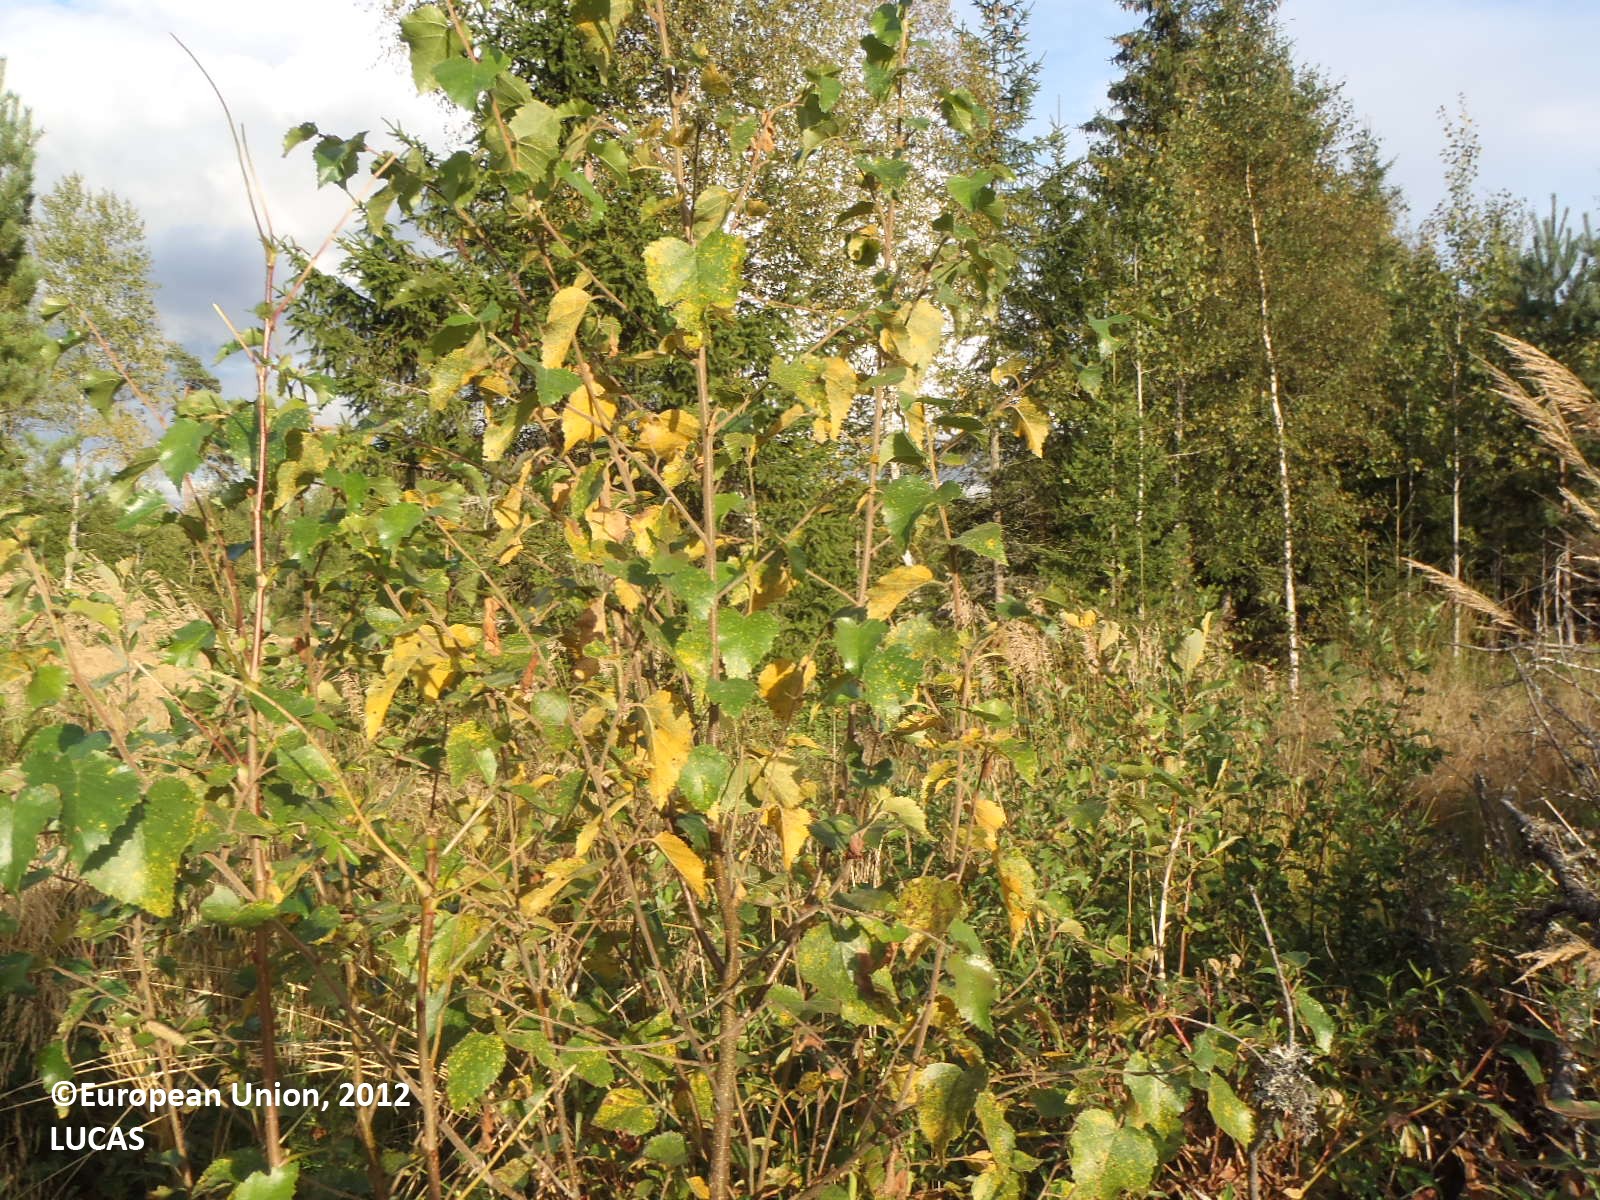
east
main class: Woodland
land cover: Broadleaved woodland
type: boreal forest
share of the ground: 10 - 25 %
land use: Forestry
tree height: < 5 m
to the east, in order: Broadleaved woodland; Ditches and canals; Grass margins; Barley; Grass margins; Ditches and canals; Spruce dominated mixed woodland; Tracks; Other coniferous woodland; Ditches and canals; Spruce dominated coniferous woodland; Ditches and canals; Pine dominated coniferous woodland; Ditches and canals; Pine dominated coniferous woodland; Ditches and canals; Pine dominated coniferous woodland; Ditches and canals; Pine dominated coniferous woodland; Ditches and canals; Abandoned hedges; Paved roads, cycling and walking lanes
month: August
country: FI
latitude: 60.6137
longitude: 22.4370
